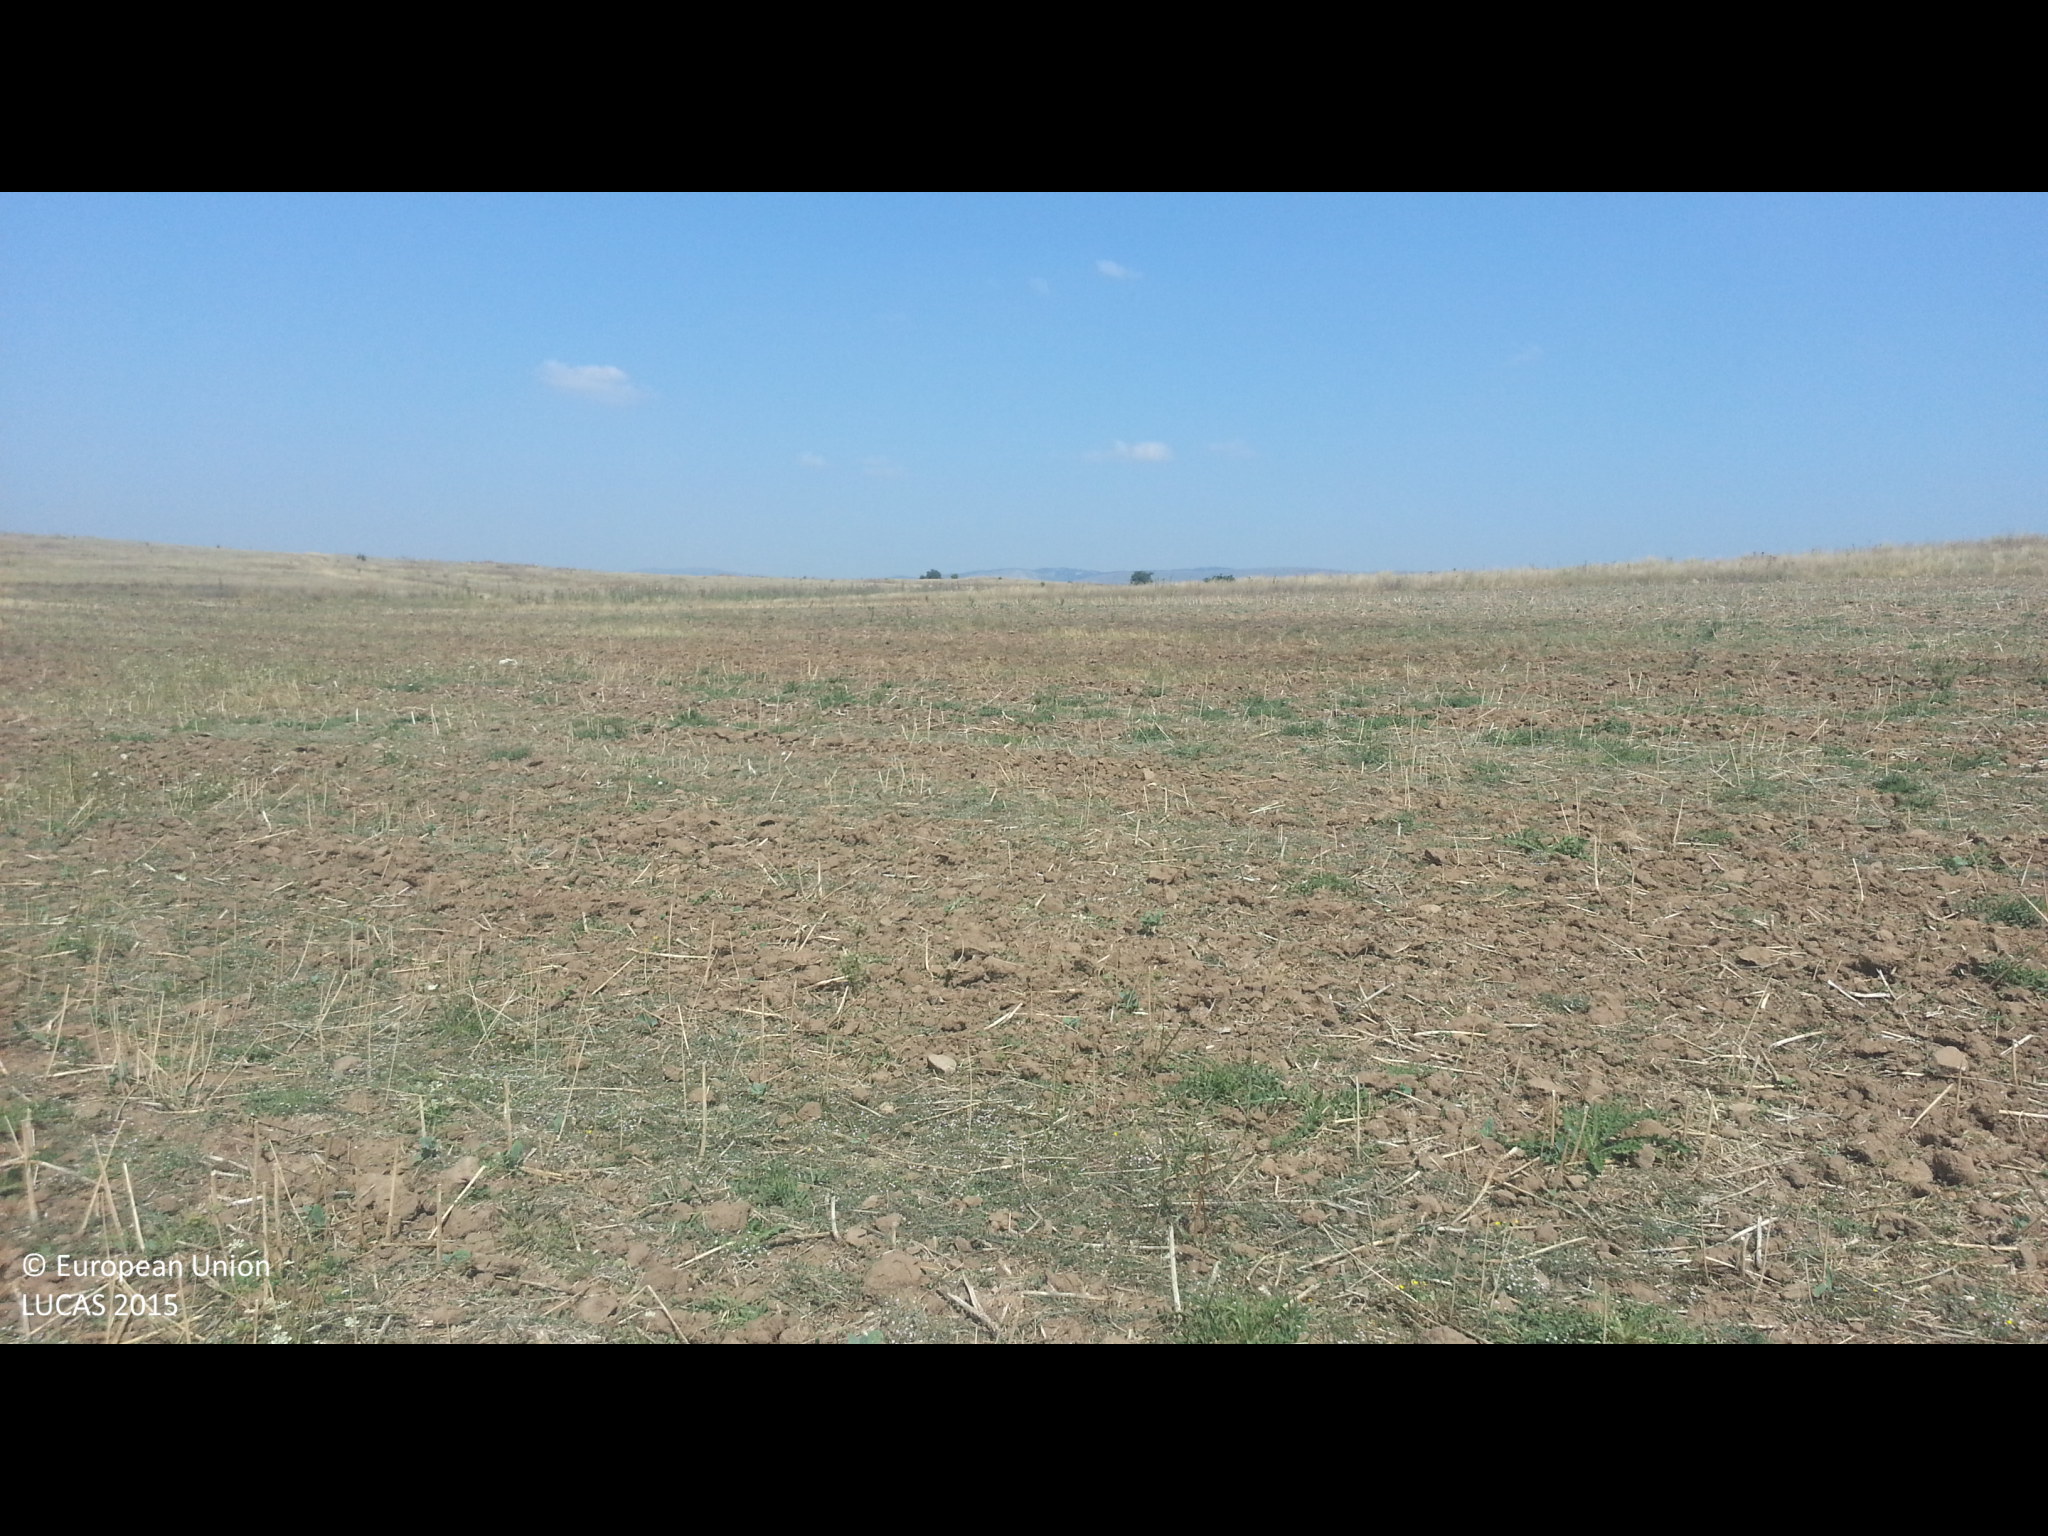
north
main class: Grassland
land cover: Spontaneously vegetated surfaces
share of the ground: 25 - 50 %
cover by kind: consolidated bare surface 65 %, herbaceous plants 35 %
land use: Agriculture (excluding fallow land and kitchen gardens)
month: August
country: BG
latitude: 42.4421
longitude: 23.0731
